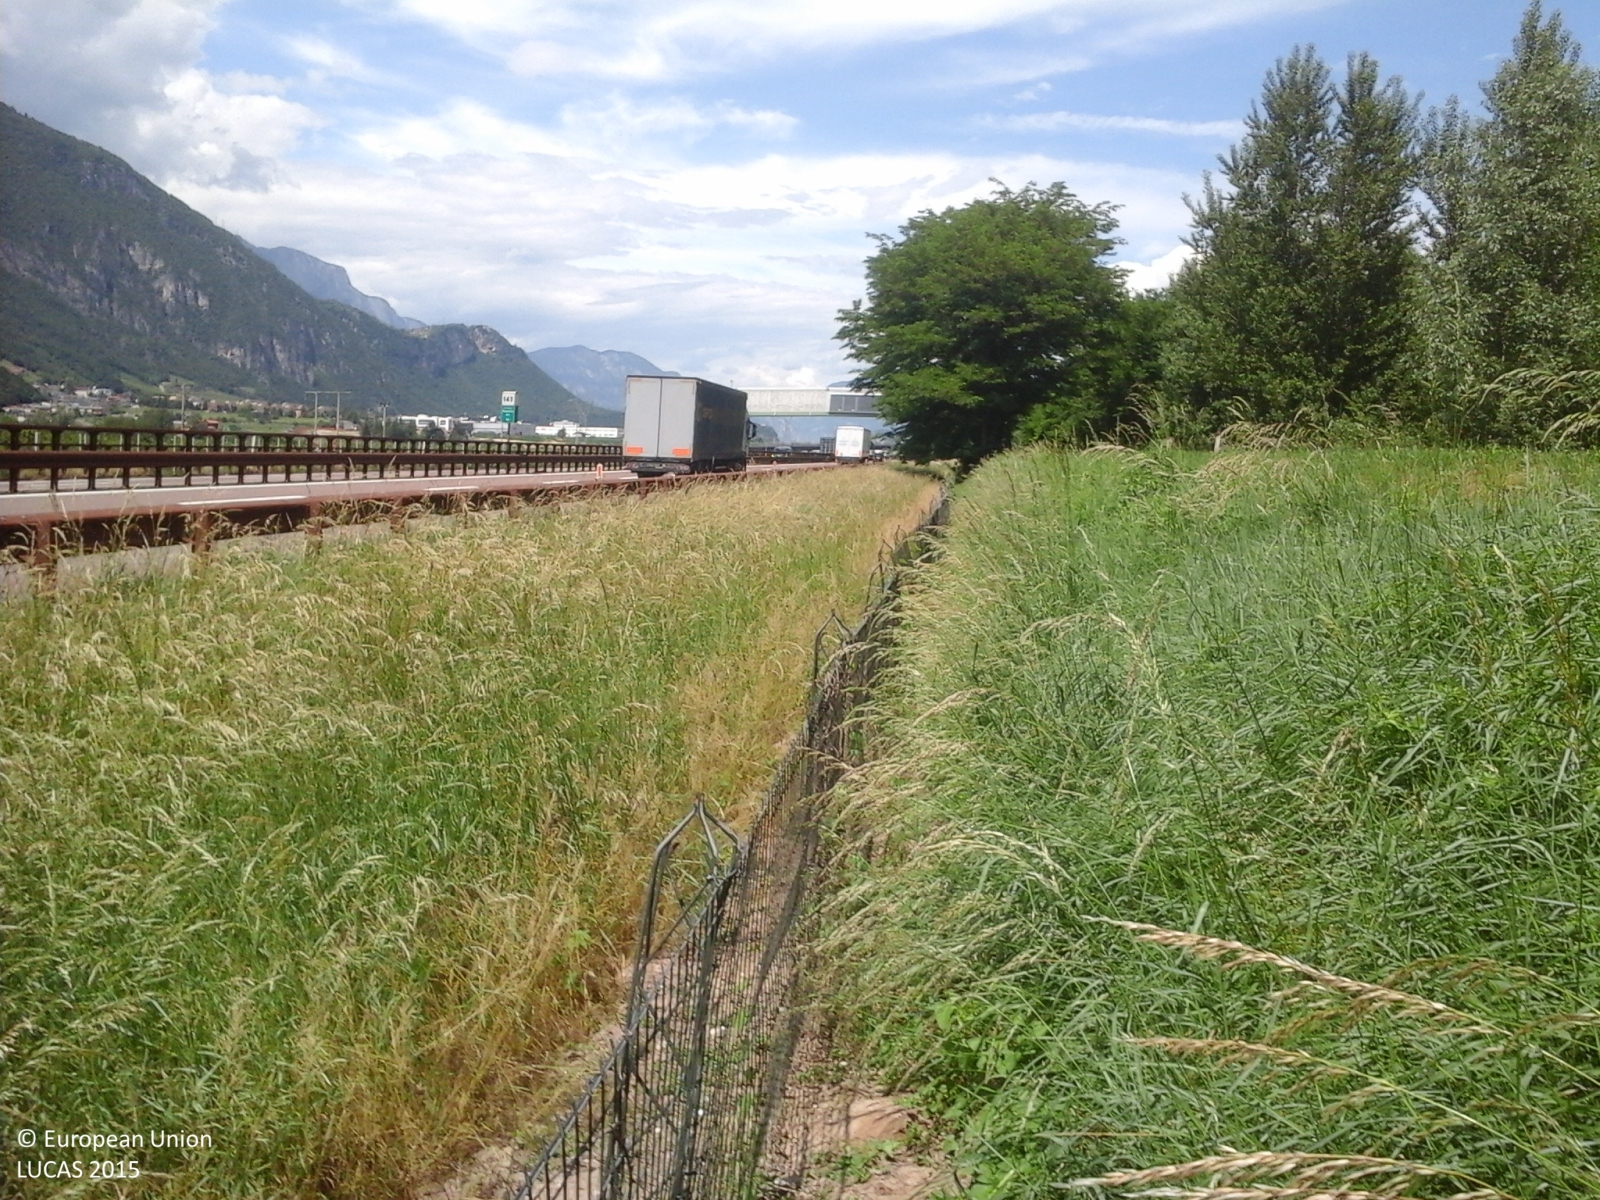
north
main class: Grassland
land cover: Grassland without tree/shrub cover
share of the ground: 25 - 50 %
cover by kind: herbaceous plants 70 %, consolidated bare surface 30 %
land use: Road transport
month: May
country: IT
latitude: 46.0210
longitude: 11.1222
